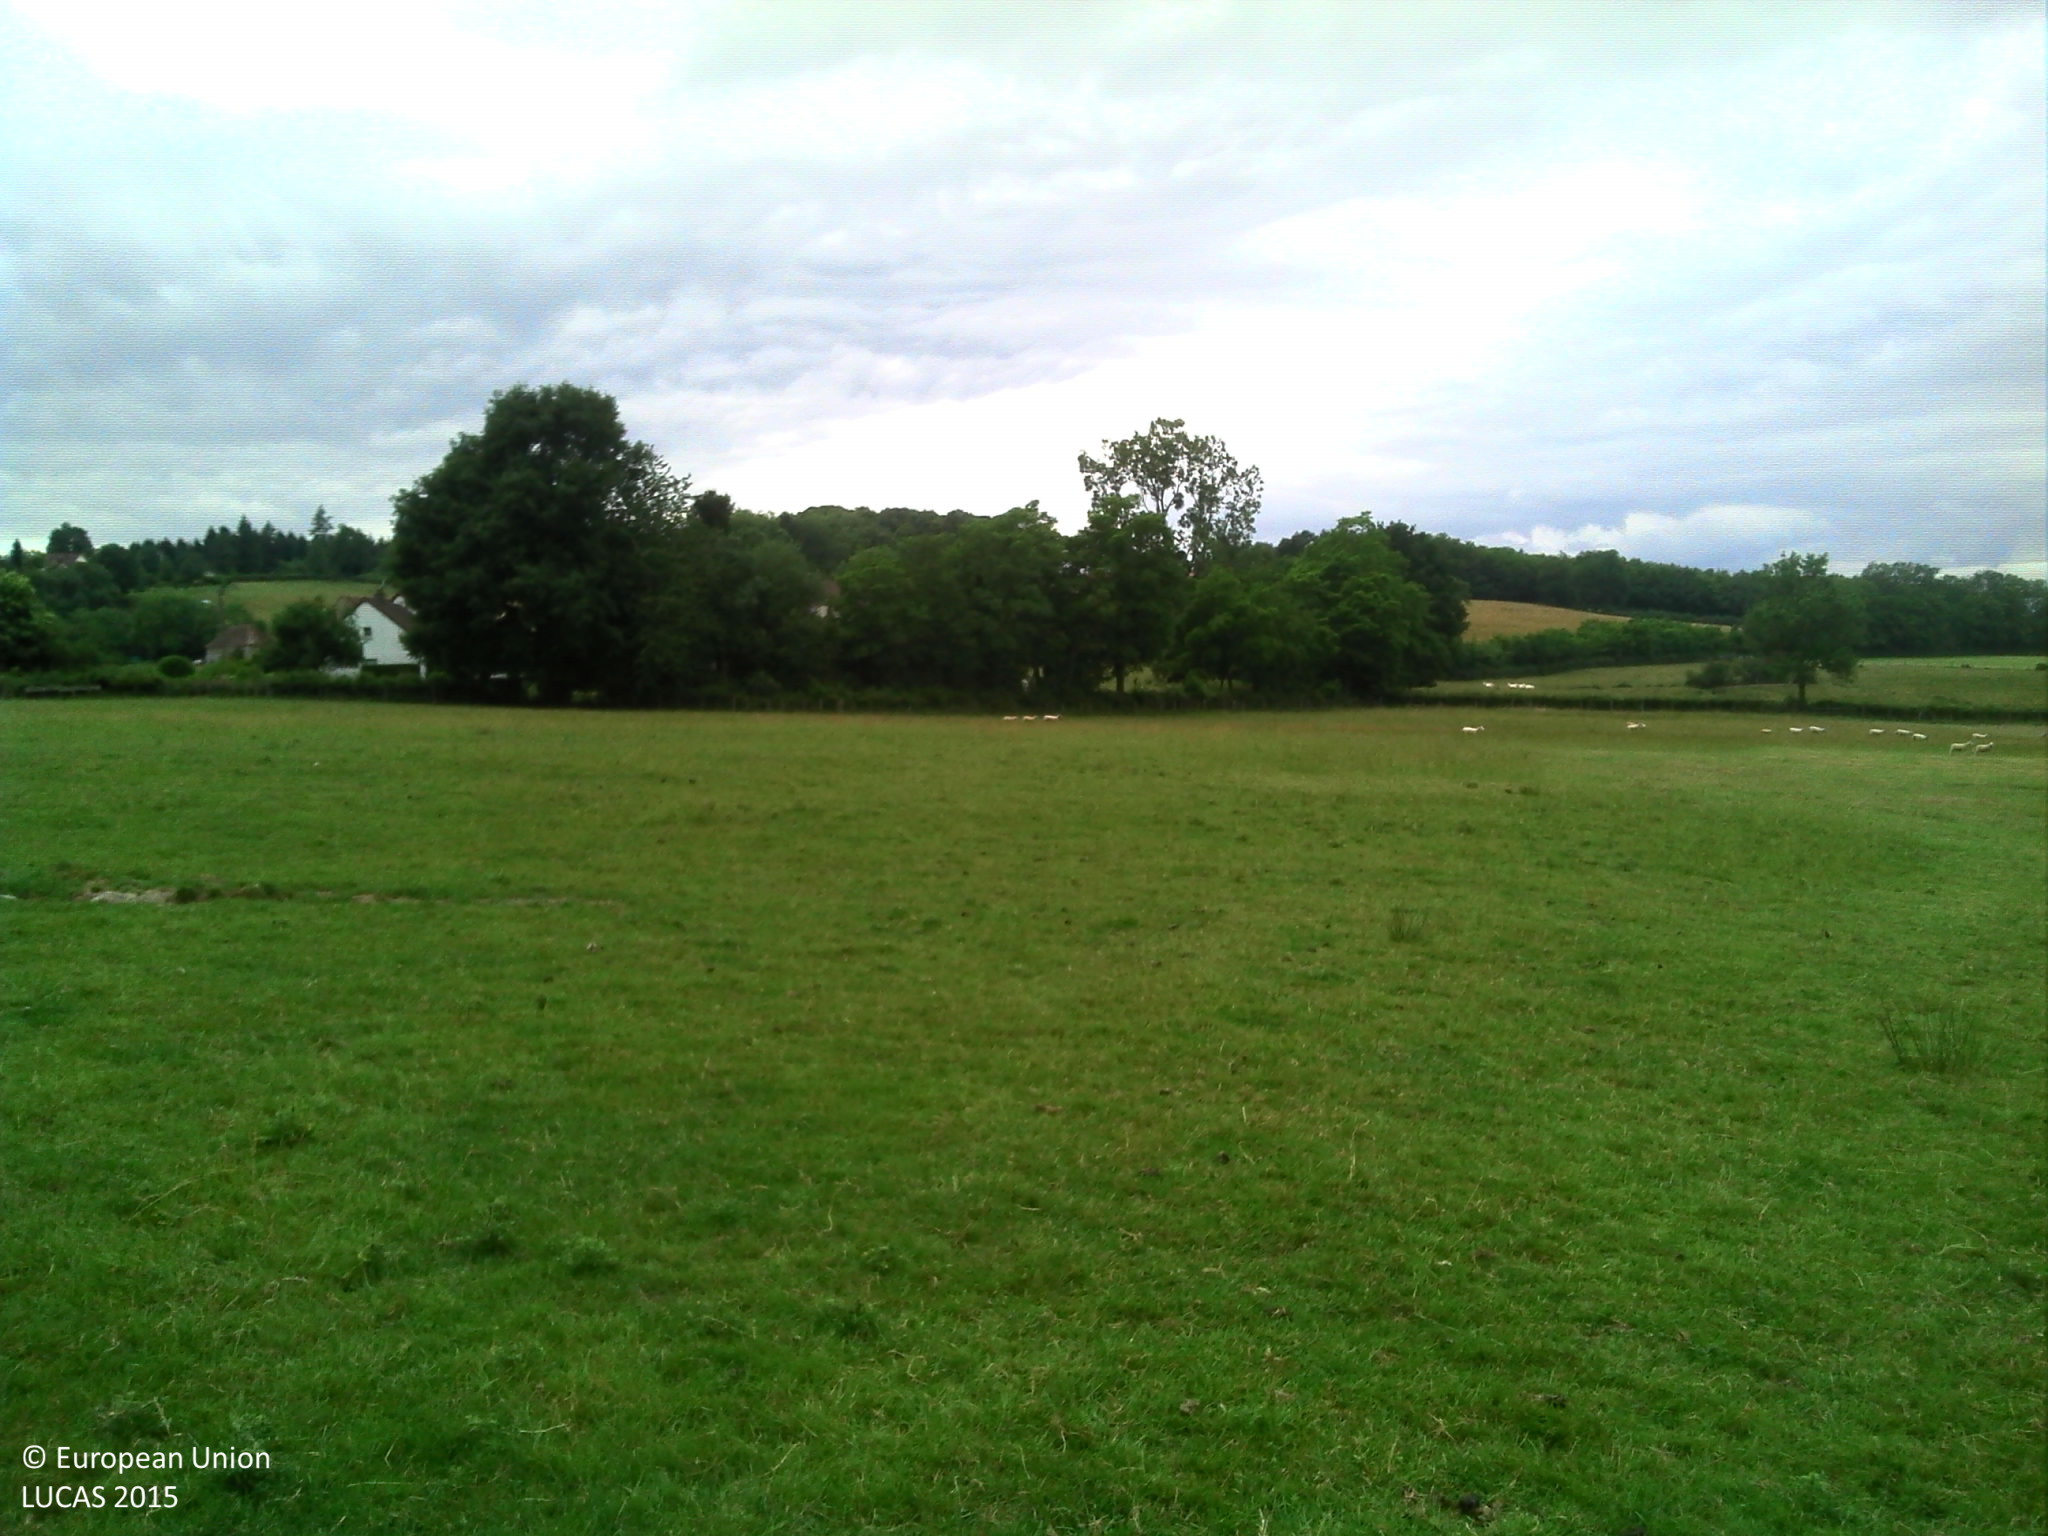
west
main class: Grassland
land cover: Grassland without tree/shrub cover
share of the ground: > 75 %
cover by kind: herbaceous plants 100 %
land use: Agriculture (excluding fallow land and kitchen gardens)
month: June
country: FR
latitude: 46.5505
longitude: 4.4581
